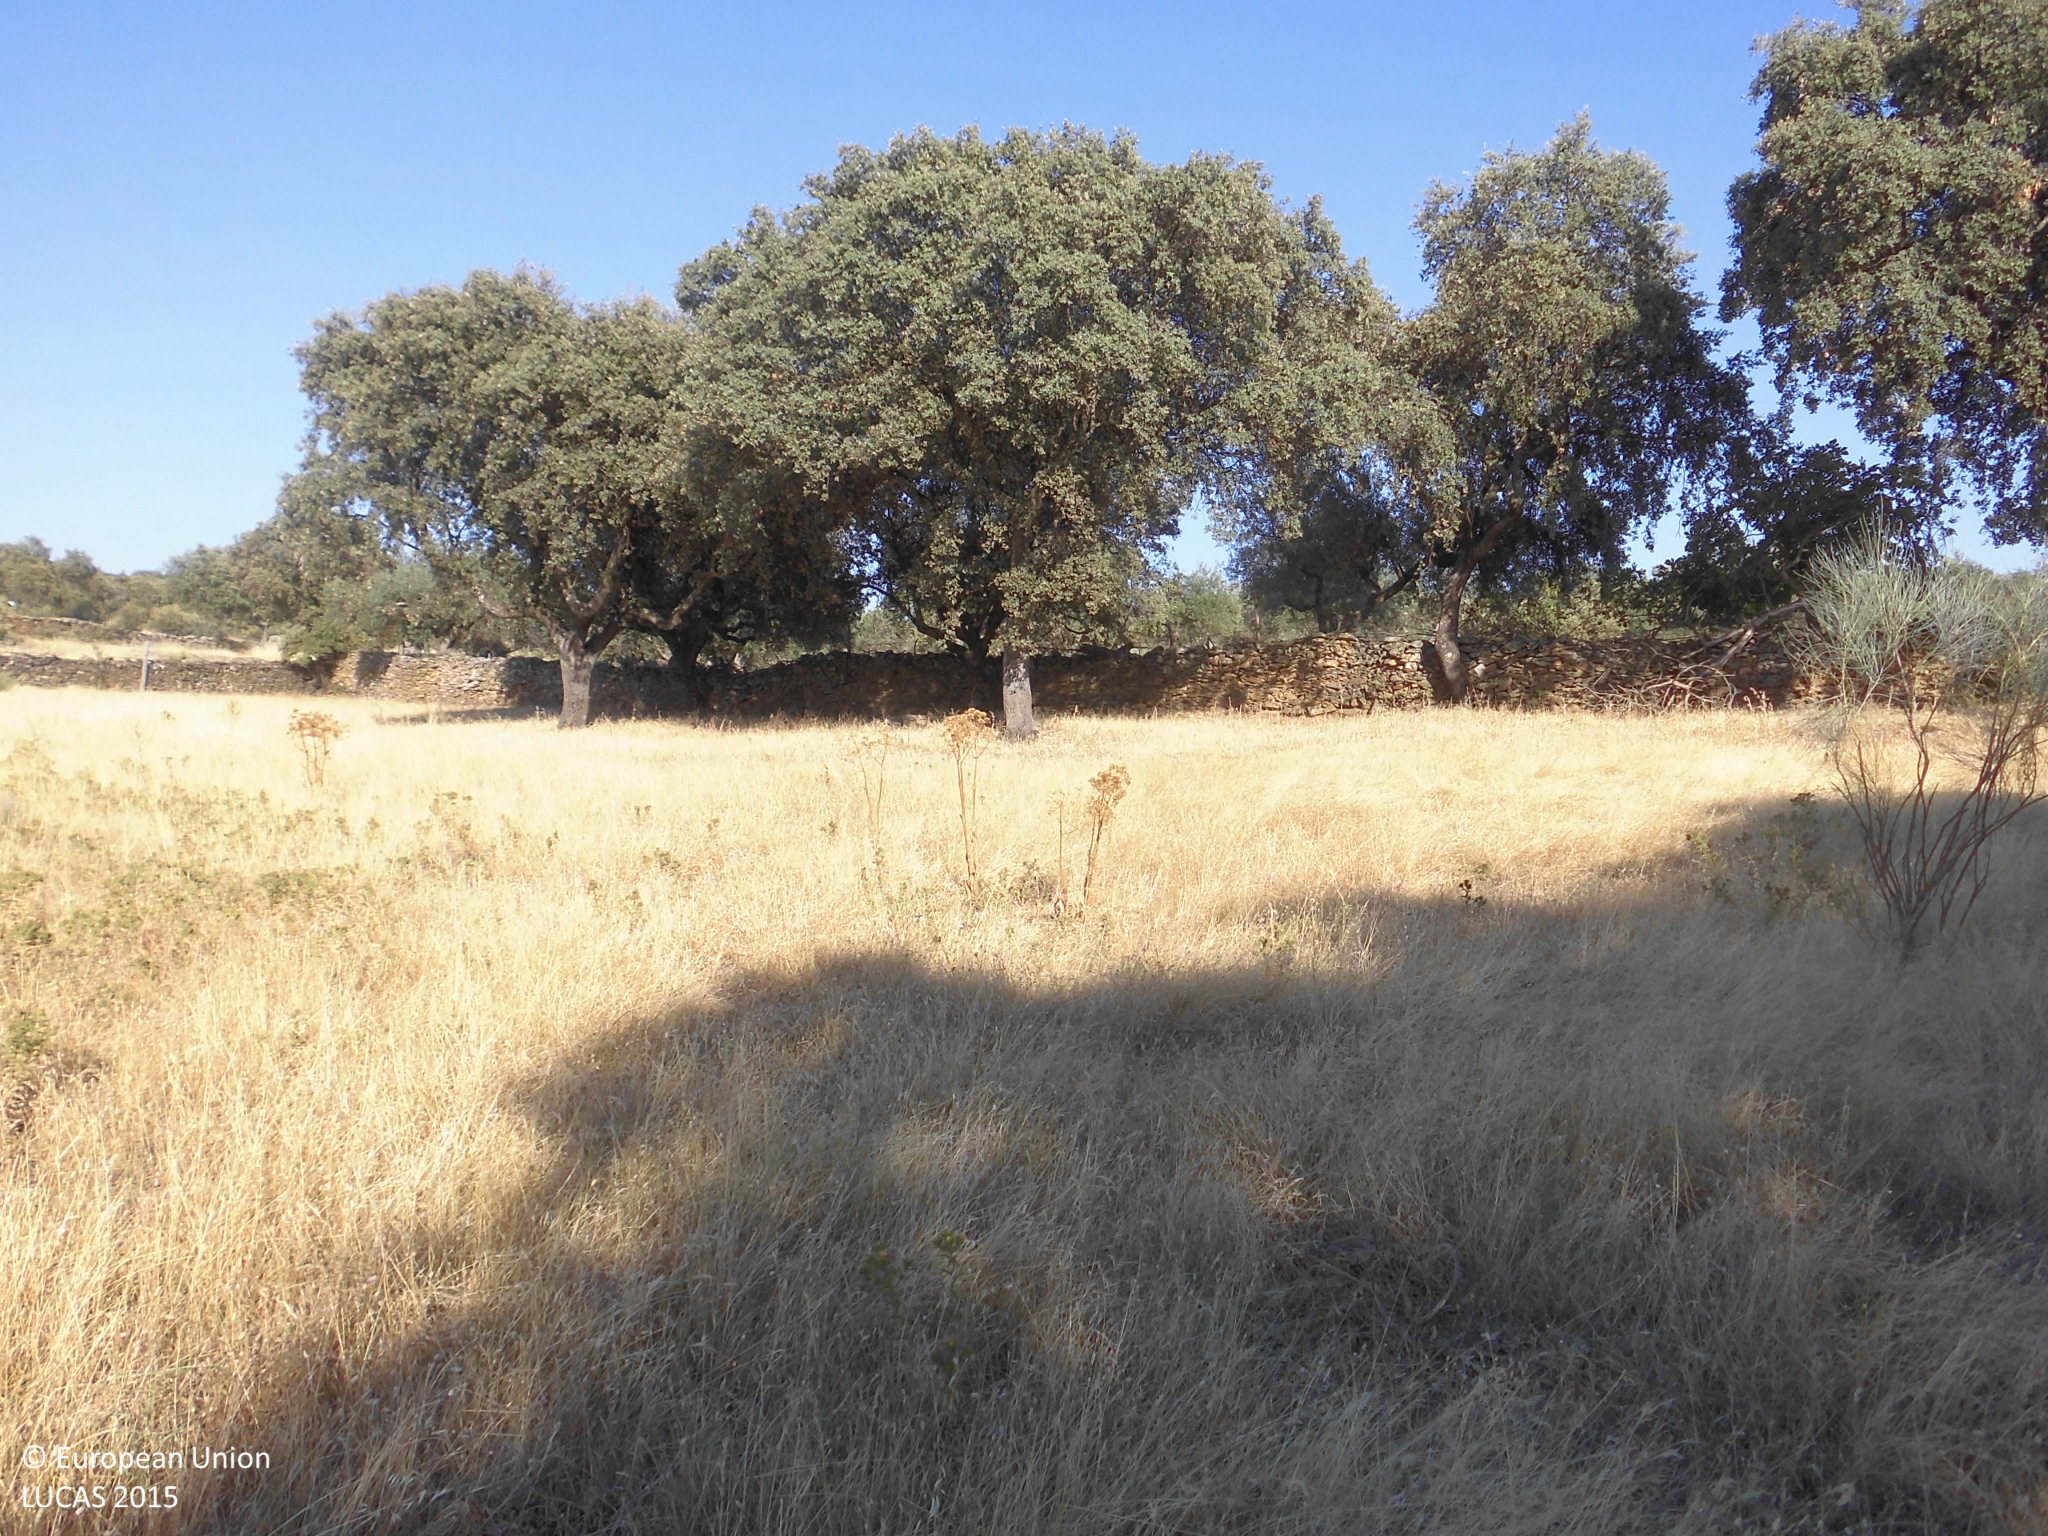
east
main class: Grassland
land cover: Grassland with sparse tree/shrub cover
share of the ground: > 75 %
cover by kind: herbaceous plants 95 %, broadleaved forest trees 5 %
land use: Agriculture (excluding fallow land and kitchen gardens)
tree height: > 5 m
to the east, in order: Grassland with sparse tree/shrub cover; Dry stone walls; Paved roads, cycling and walking lanes; Grassland with sparse tree/shrub cover; Dry stone walls; Shruby margins; Shrubland with sparse tree cover; Dry stone walls; Groves; Grassland with sparse tree/shrub cover; Groves
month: July
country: ES
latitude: 39.5208
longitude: -5.6304
